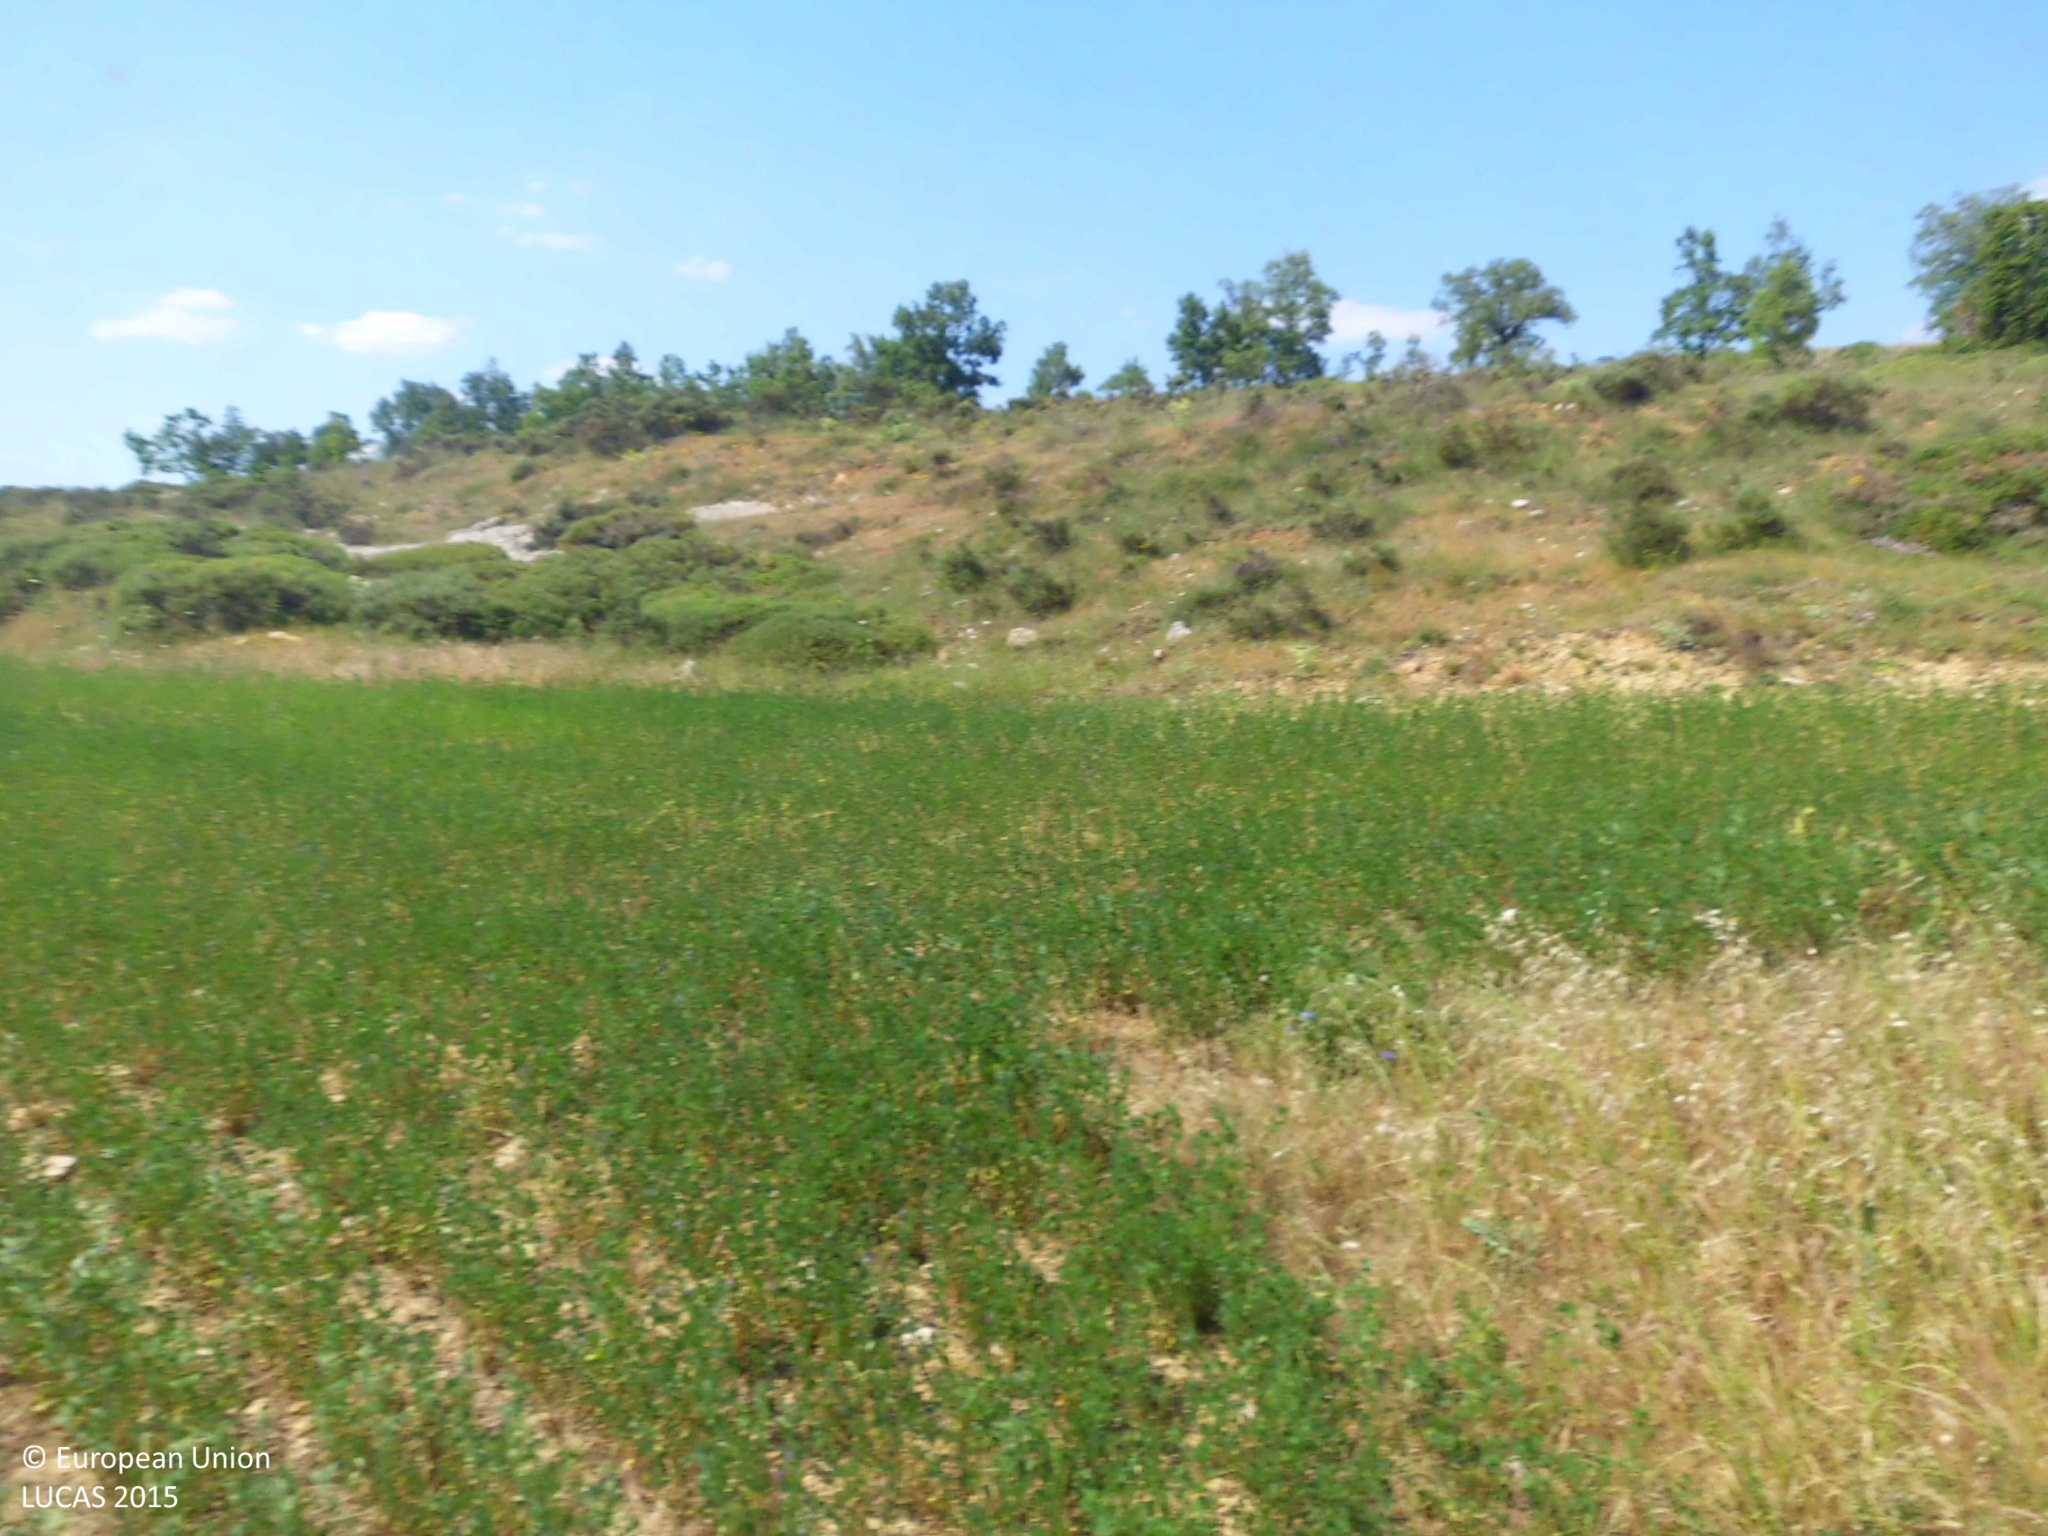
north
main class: Cropland
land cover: Lucerne
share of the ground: 50 - 75 %
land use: Agriculture (excluding fallow land and kitchen gardens)
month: June
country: ES
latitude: 42.8204
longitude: -4.4497
